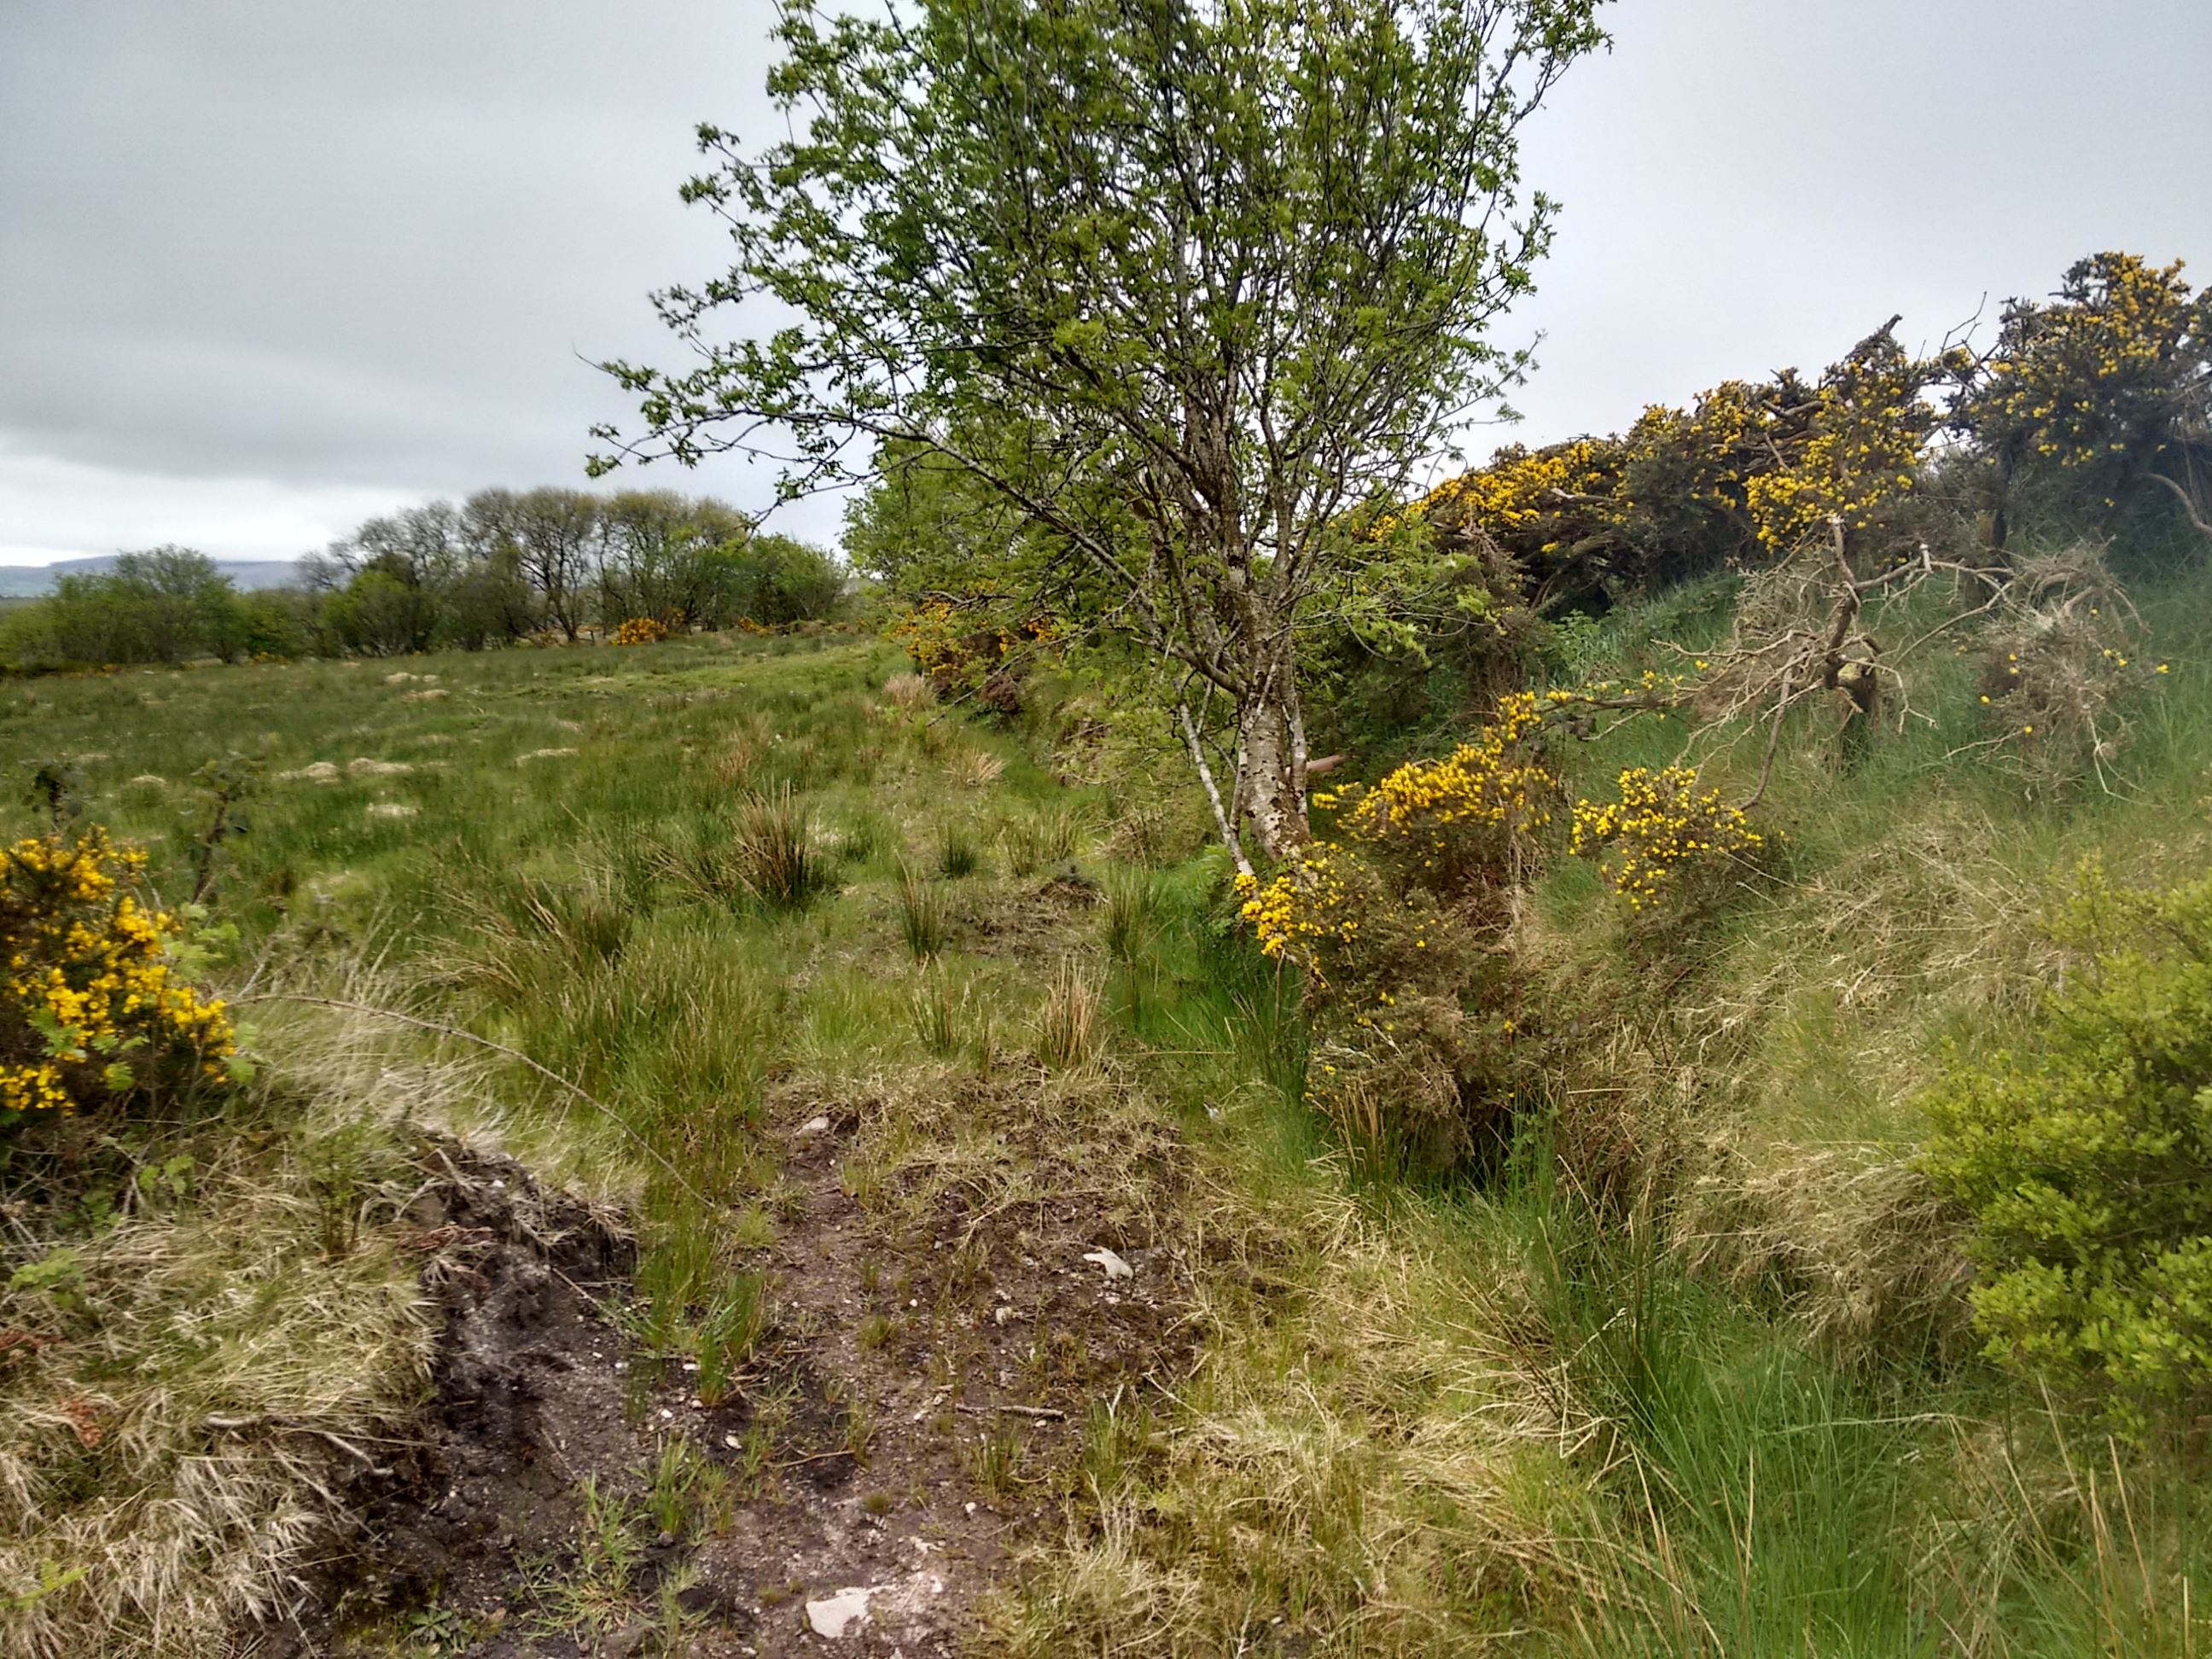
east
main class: Grassland
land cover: Grassland without tree/shrub cover
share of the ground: > 75 %
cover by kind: herbaceous plants 100 %
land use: Agriculture (excluding fallow land and kitchen gardens)
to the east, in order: Abandoned hedges; Grassland without tree/shrub cover; Ditches and canals; Abandoned hedges; Fences; Grassland without tree/shrub cover
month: May
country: GB
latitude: 54.9984
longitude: -7.0376
